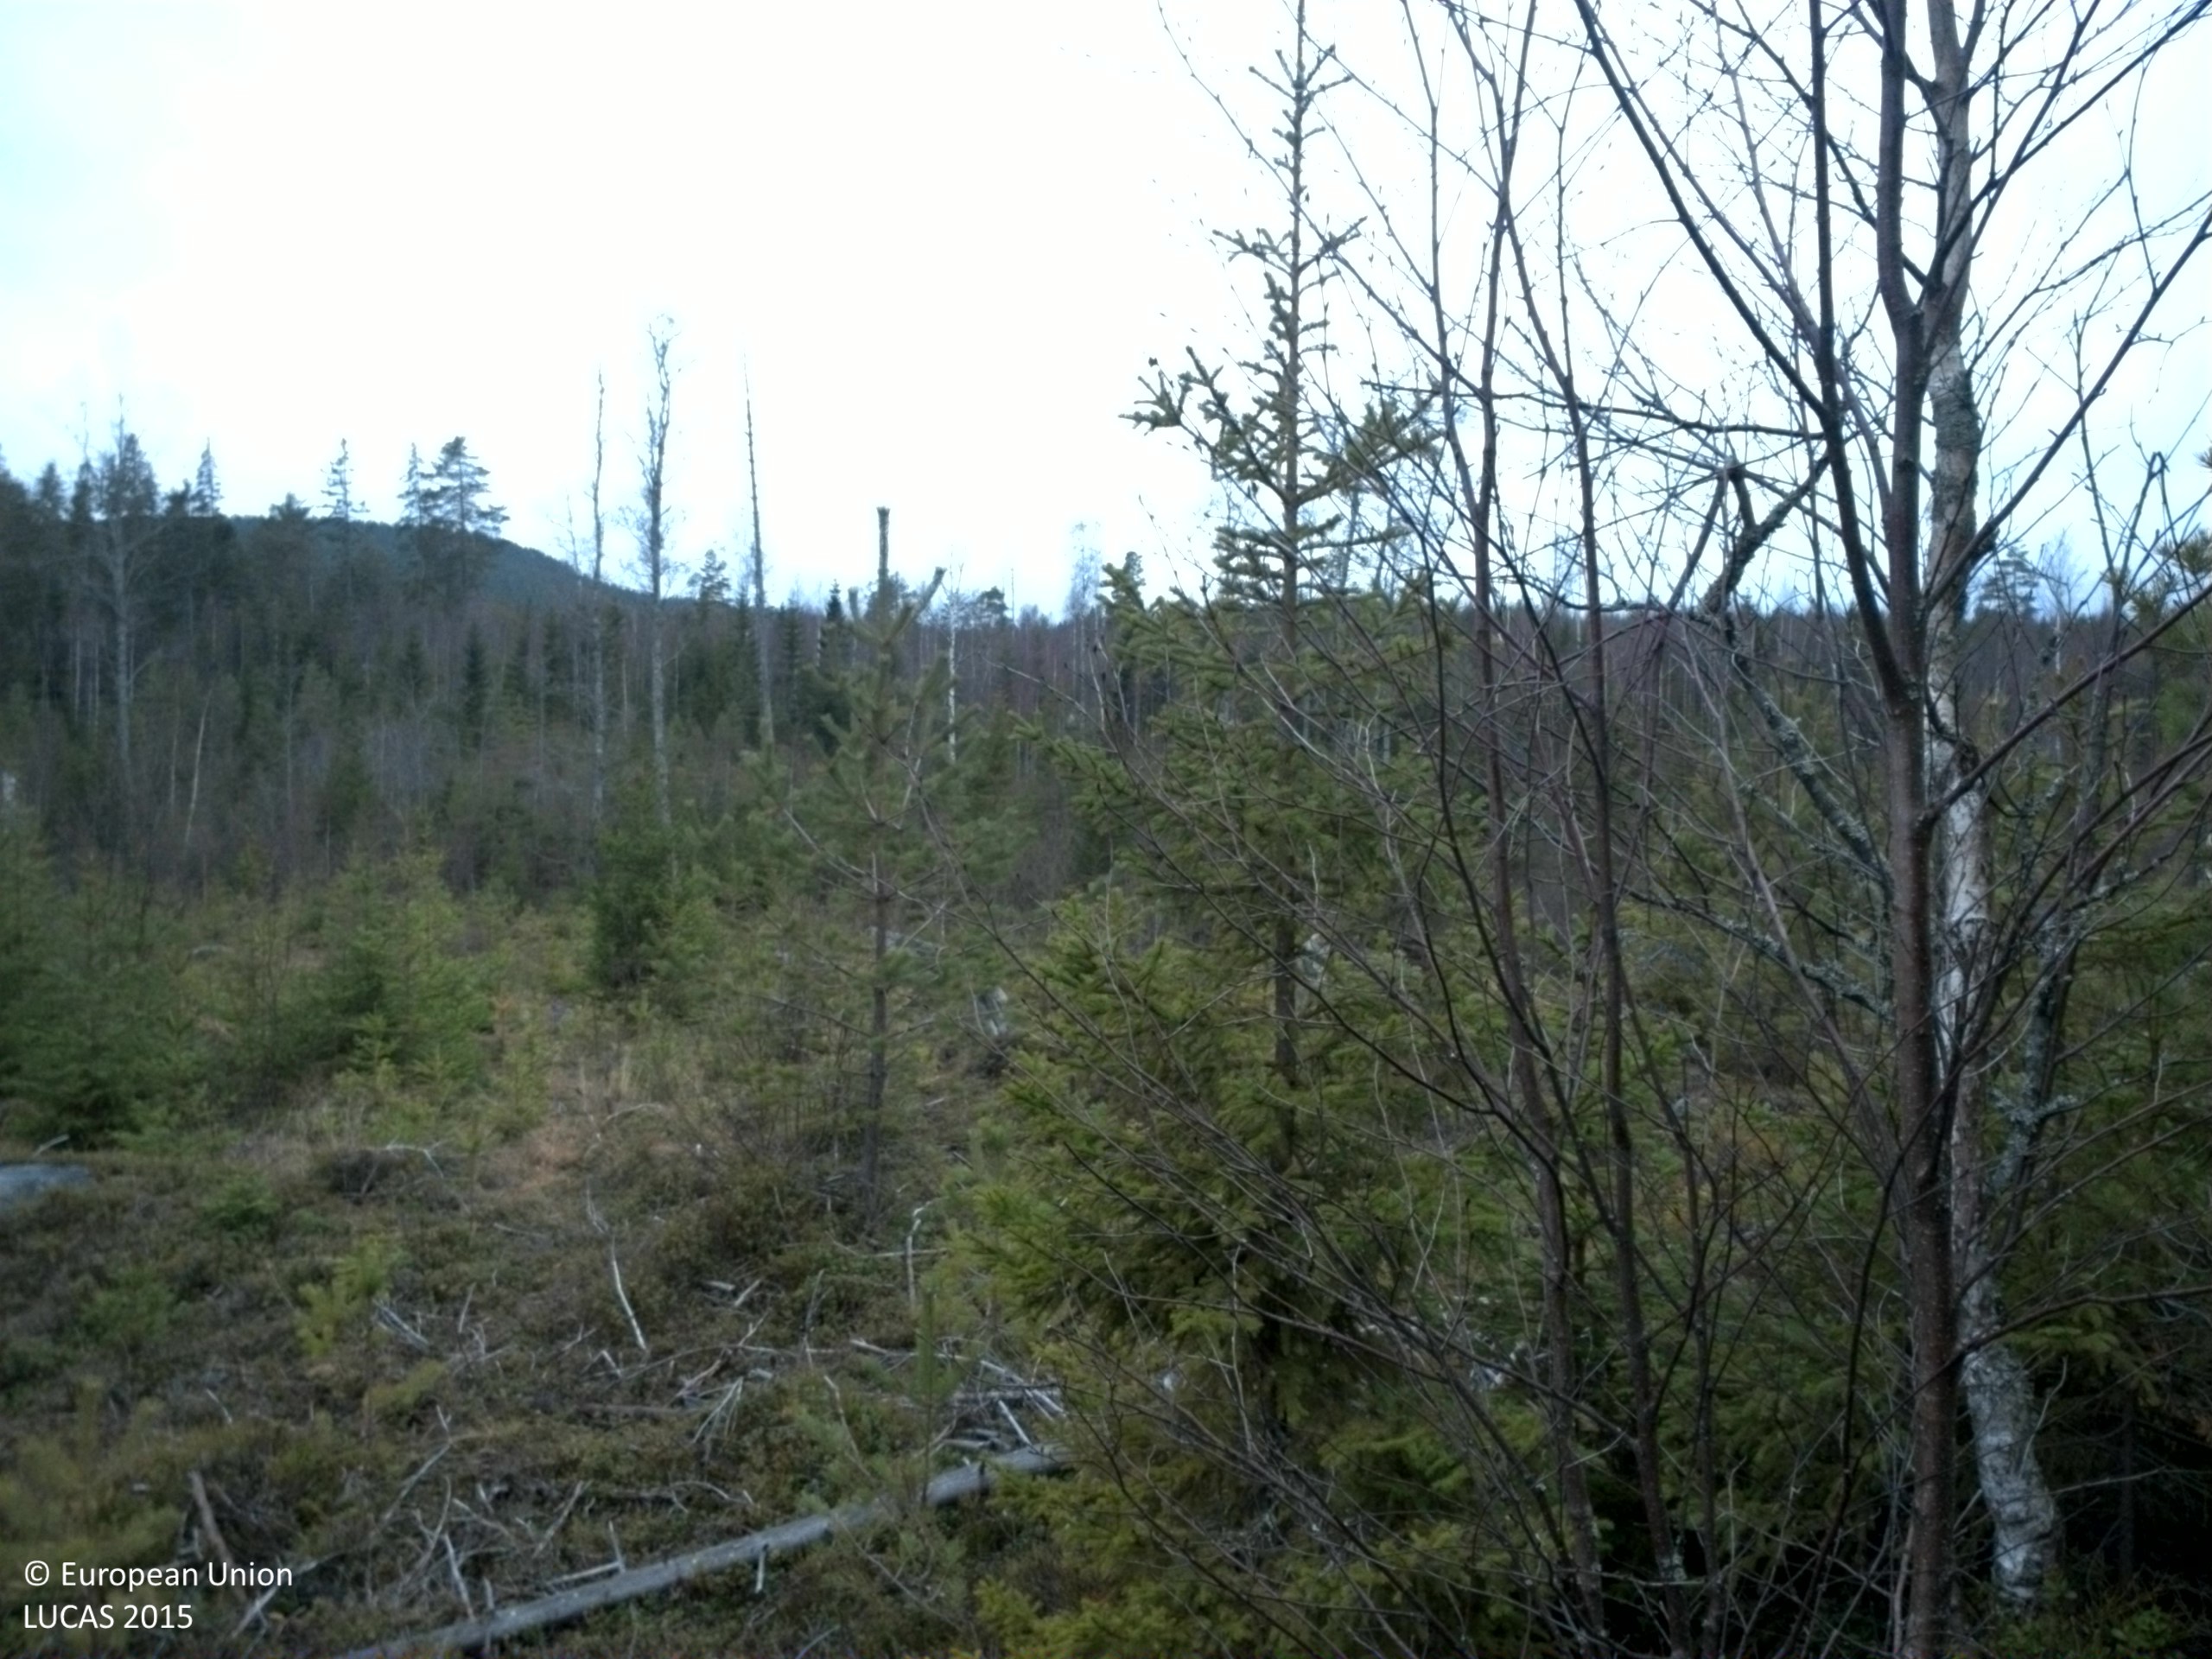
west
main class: Woodland
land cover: Other mixed woodland
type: boreal forest
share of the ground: 25 - 50 %
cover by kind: shrubs 35 %, coniferous forest trees 25 %, lichens and mosses 20 %, broadleaved forest trees 10 %, herbaceous plants 5 %, consolidated bare surface 5 %
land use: Forestry
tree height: < 5 m
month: November
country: SE
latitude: 61.5819
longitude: 16.9725
